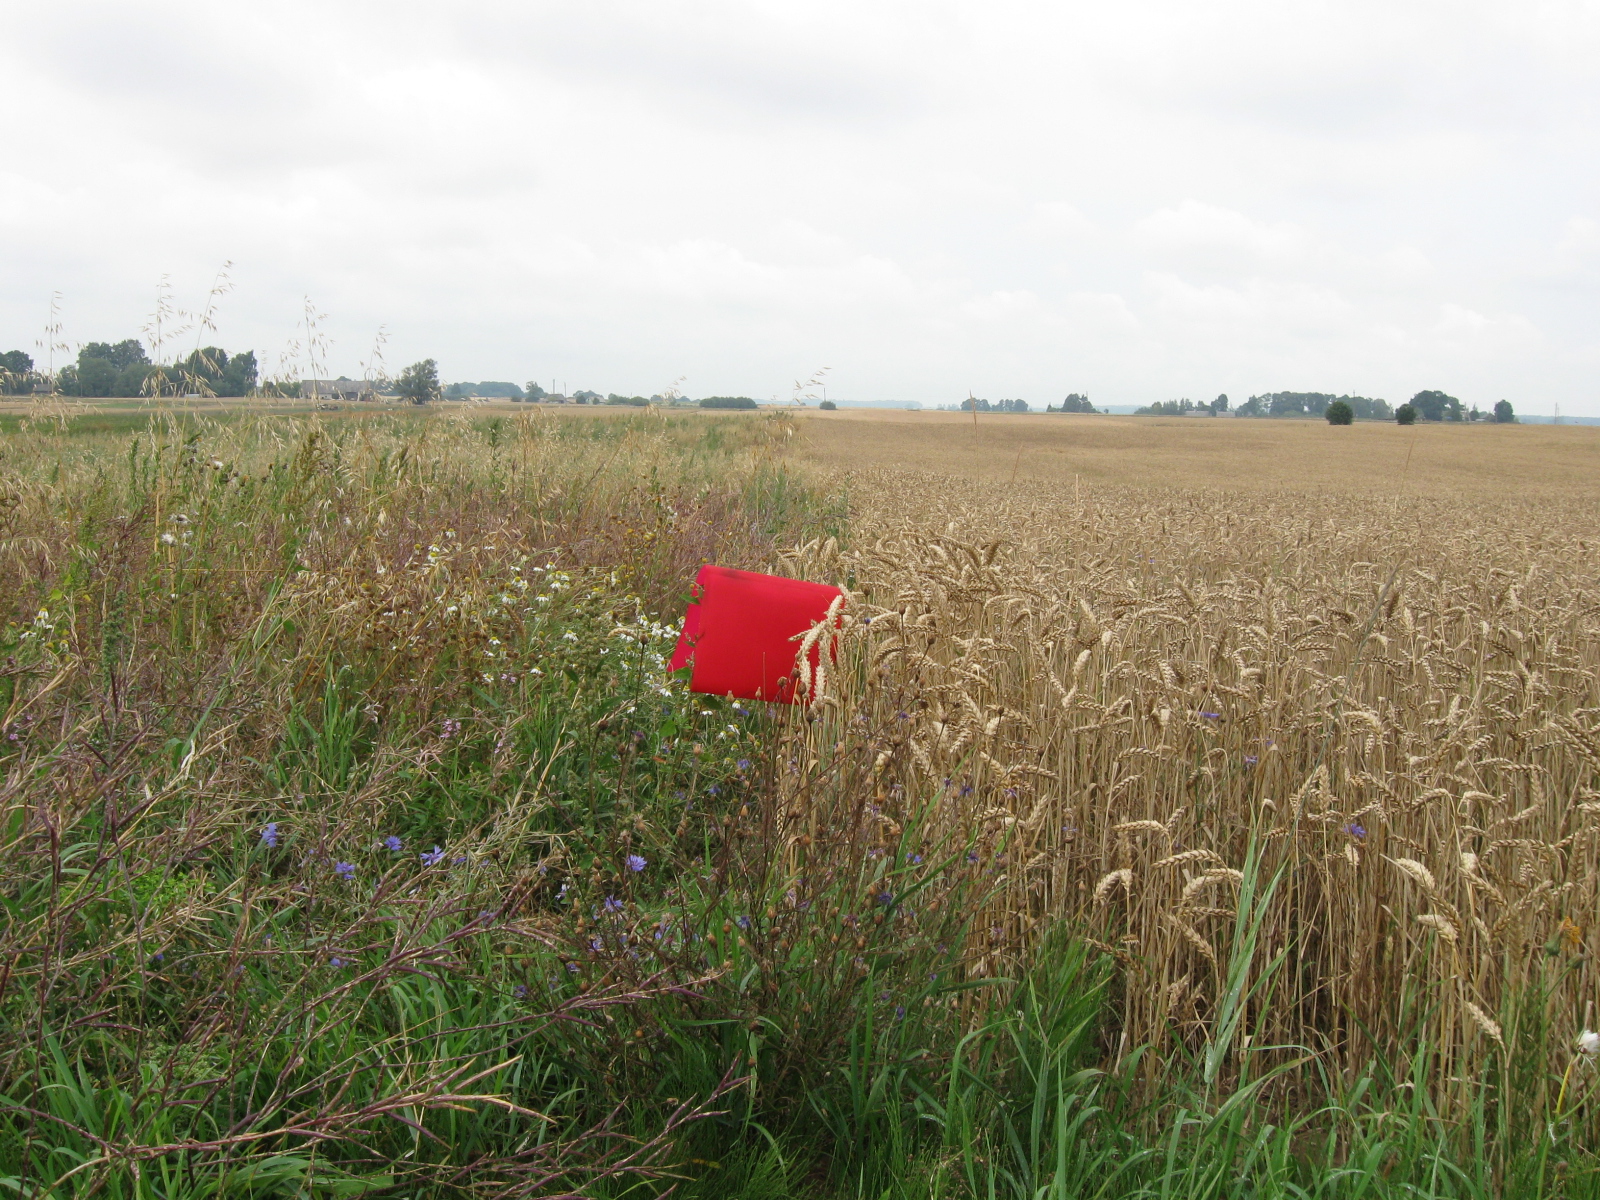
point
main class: Cropland
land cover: Common wheat
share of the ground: > 75 %
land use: Agriculture (excluding fallow land and kitchen gardens)
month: August
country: LT
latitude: 54.6113
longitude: 23.5060
